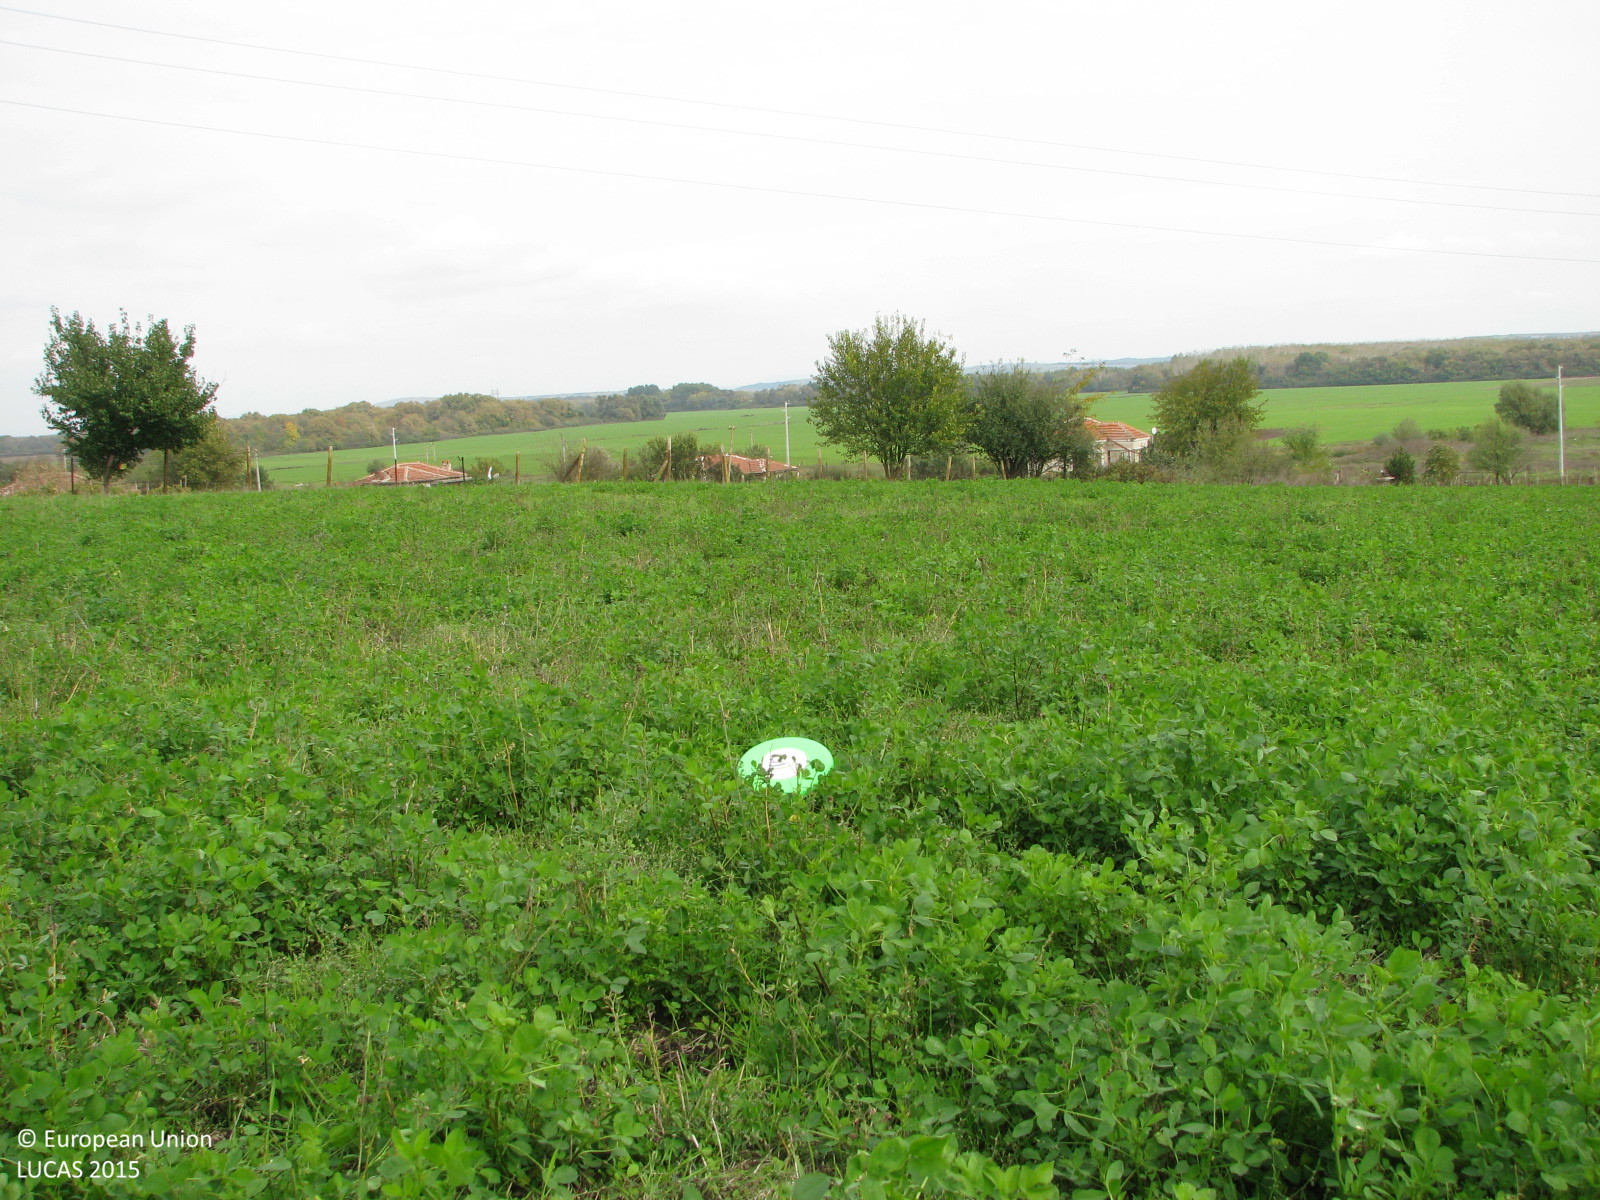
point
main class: Cropland
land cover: Lucerne
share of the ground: > 75 %
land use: Agriculture (excluding fallow land and kitchen gardens)
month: October
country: BG
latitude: 42.2191
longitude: 26.5534
